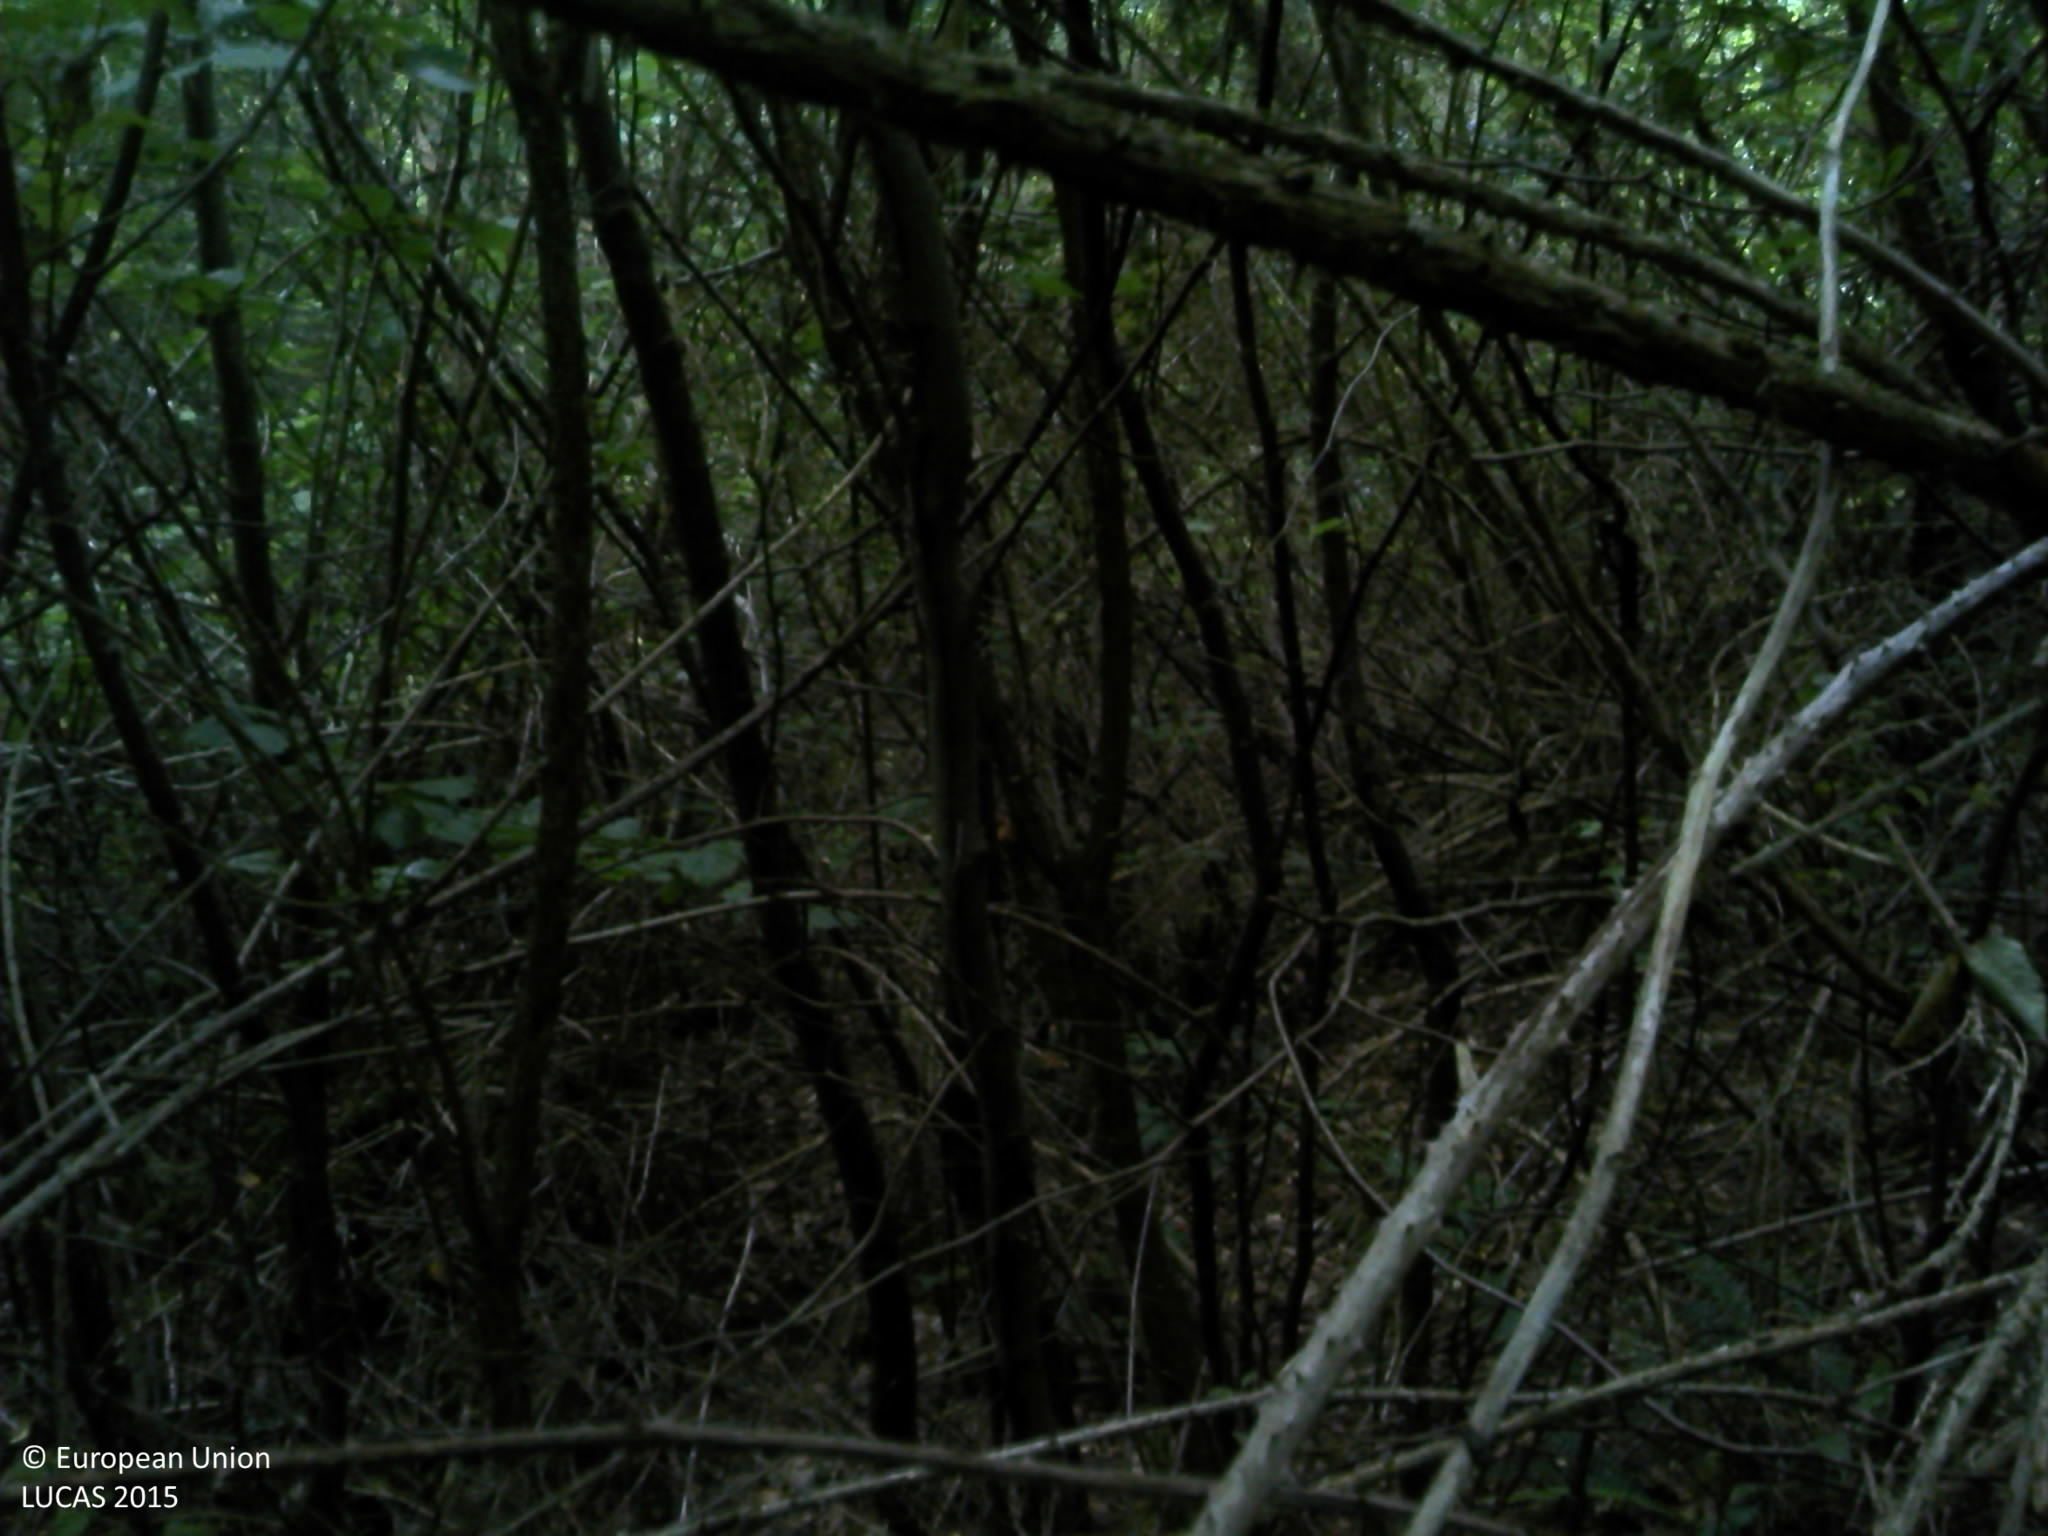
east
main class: Woodland
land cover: Broadleaved woodland
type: mesophytic deciduous forest
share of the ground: > 75 %
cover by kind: broadleaved forest trees 90 %, shrubs 10 %
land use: Forestry
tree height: > 5 m
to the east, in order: Broadleaved woodland; Spontaneously vegetated surfaces; Electric lines; Spontaneously vegetated surfaces; Spruce dominated coniferous woodland
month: July
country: FR
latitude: 48.4431
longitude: -4.2474
